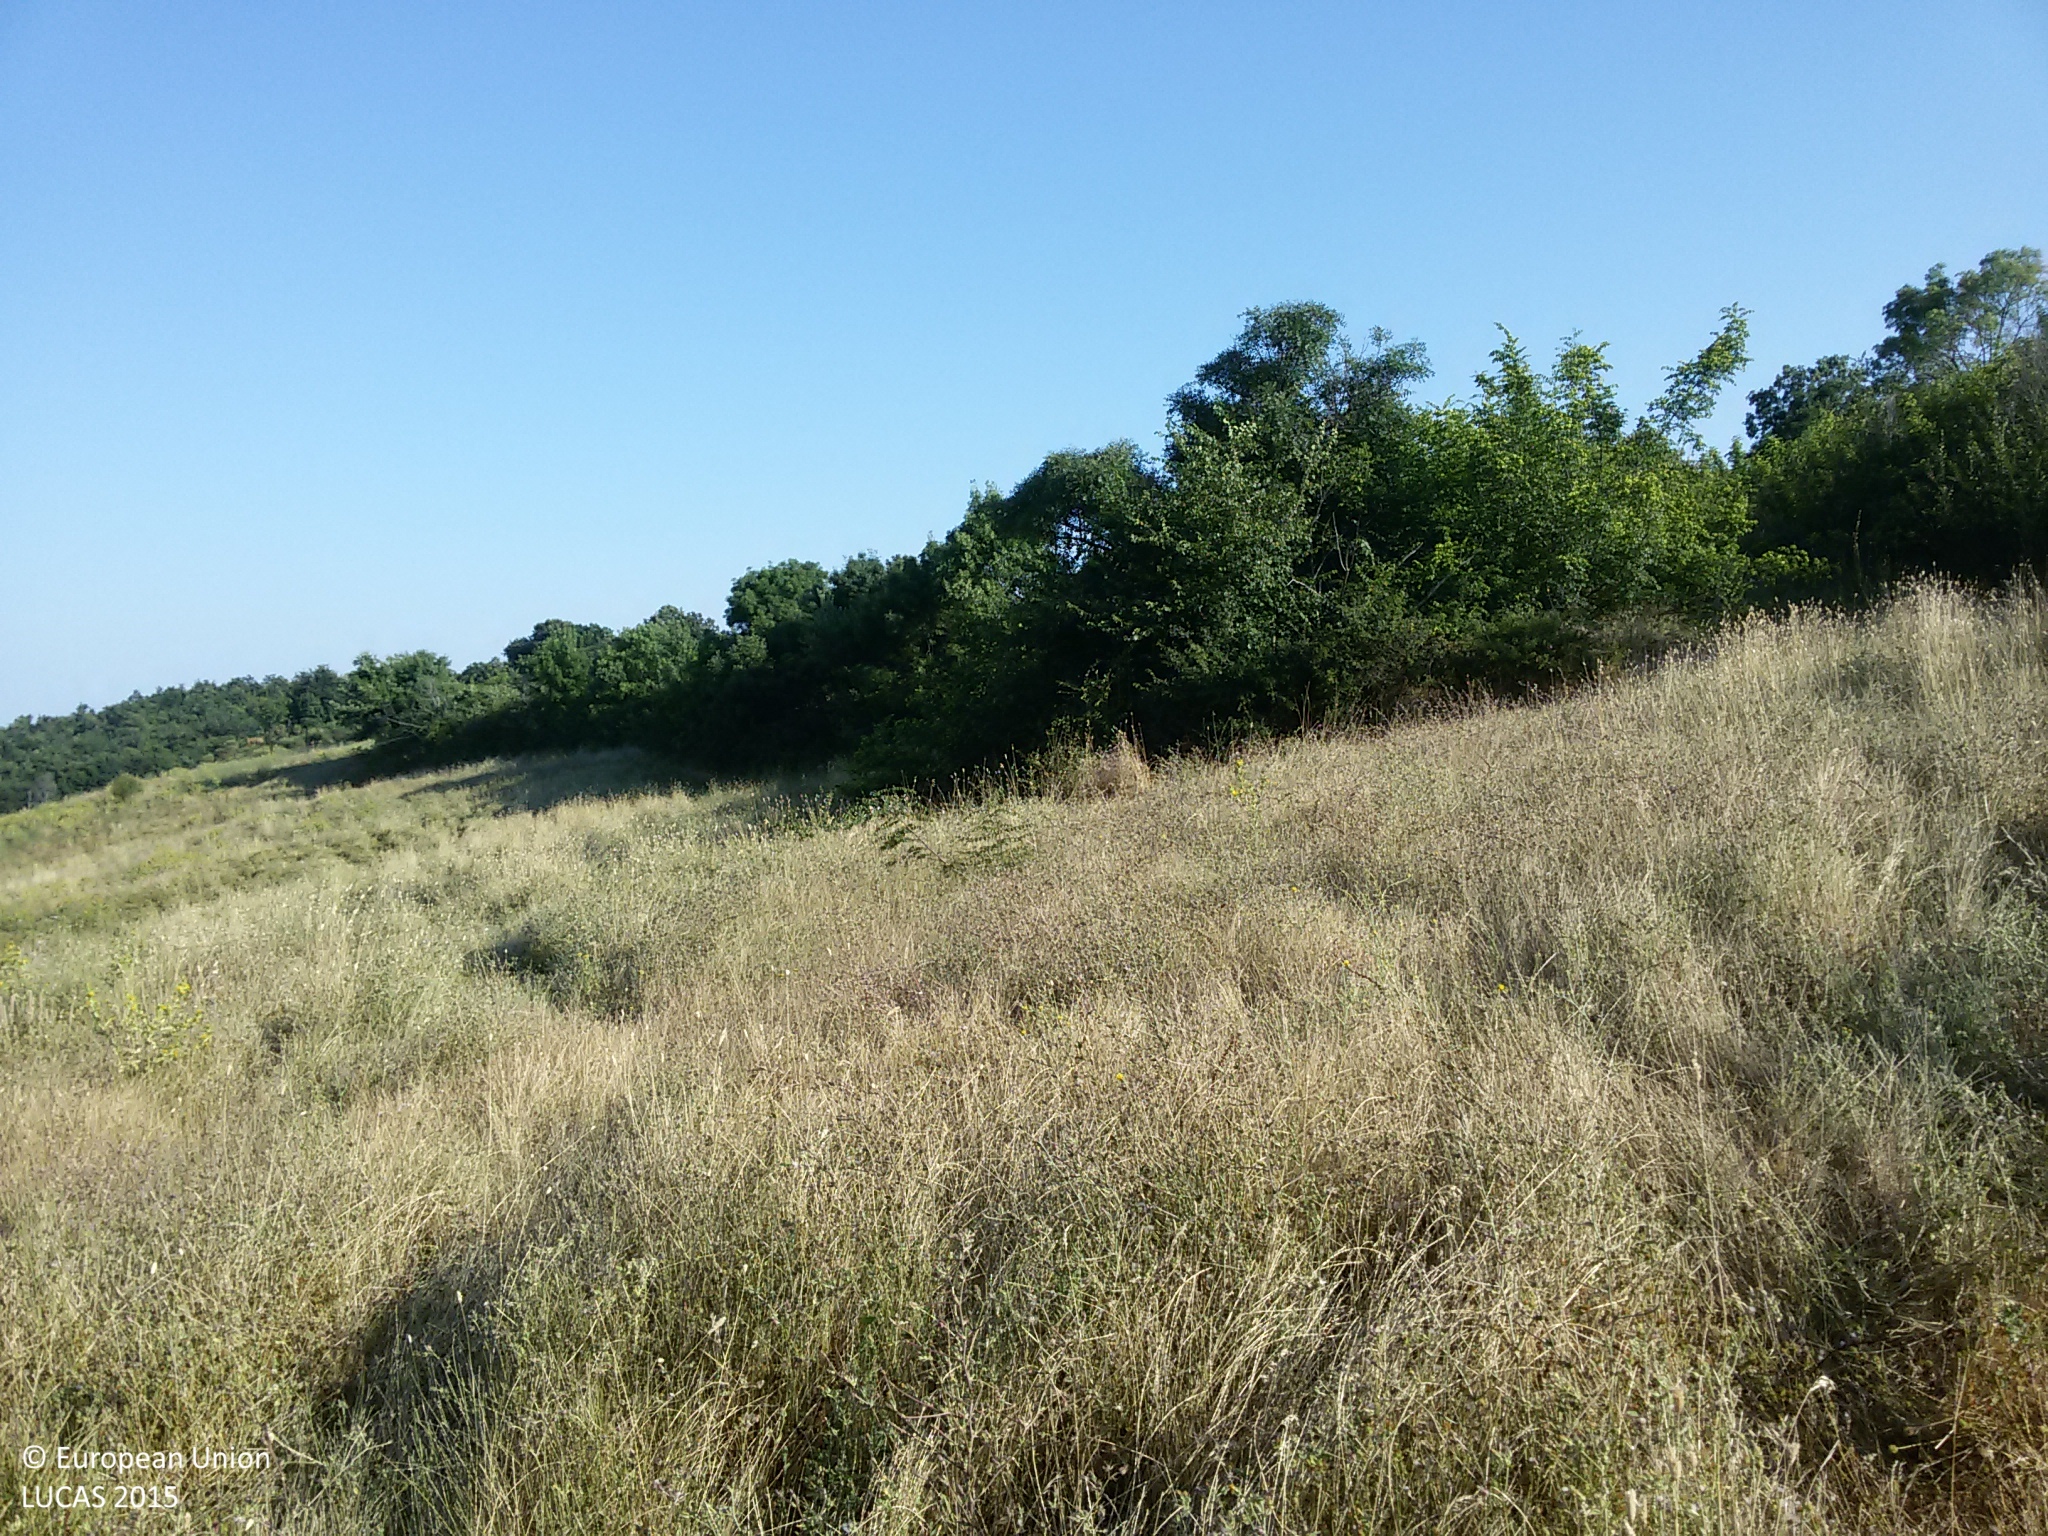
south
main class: Woodland
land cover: Broadleaved woodland
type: thermophilous deciduous forest
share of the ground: > 75 %
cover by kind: broadleaved forest trees 75 %, shrubs 20 %, herbaceous plants 5 %
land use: Forestry
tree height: > 5 m
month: July
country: IT
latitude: 42.7340
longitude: 11.4488
